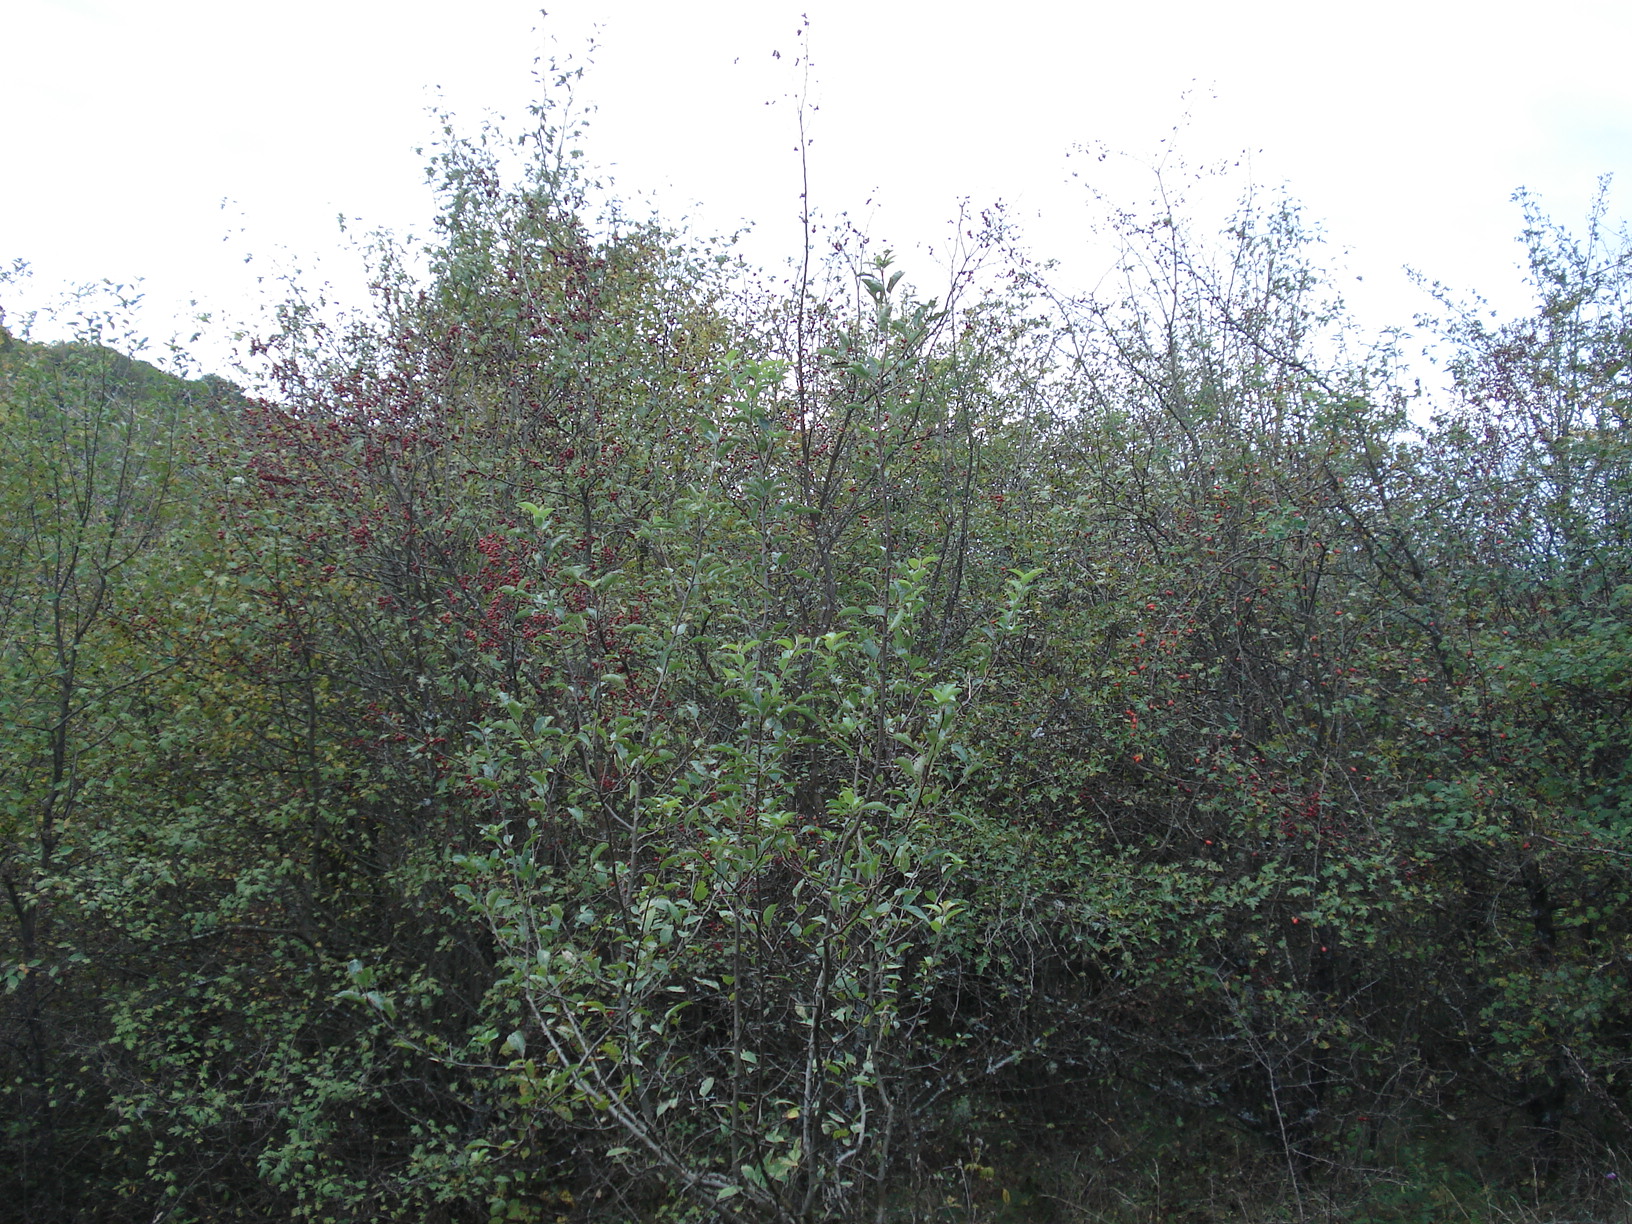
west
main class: Woodland
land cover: Broadleaved woodland
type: mesophytic deciduous forest
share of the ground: 50 - 75 %
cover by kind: broadleaved forest trees 60 %, herbaceous plants 30 %, shrubs 10 %
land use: Forestry
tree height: > 5 m
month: October
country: BG
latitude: 42.9632
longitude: 26.1623
